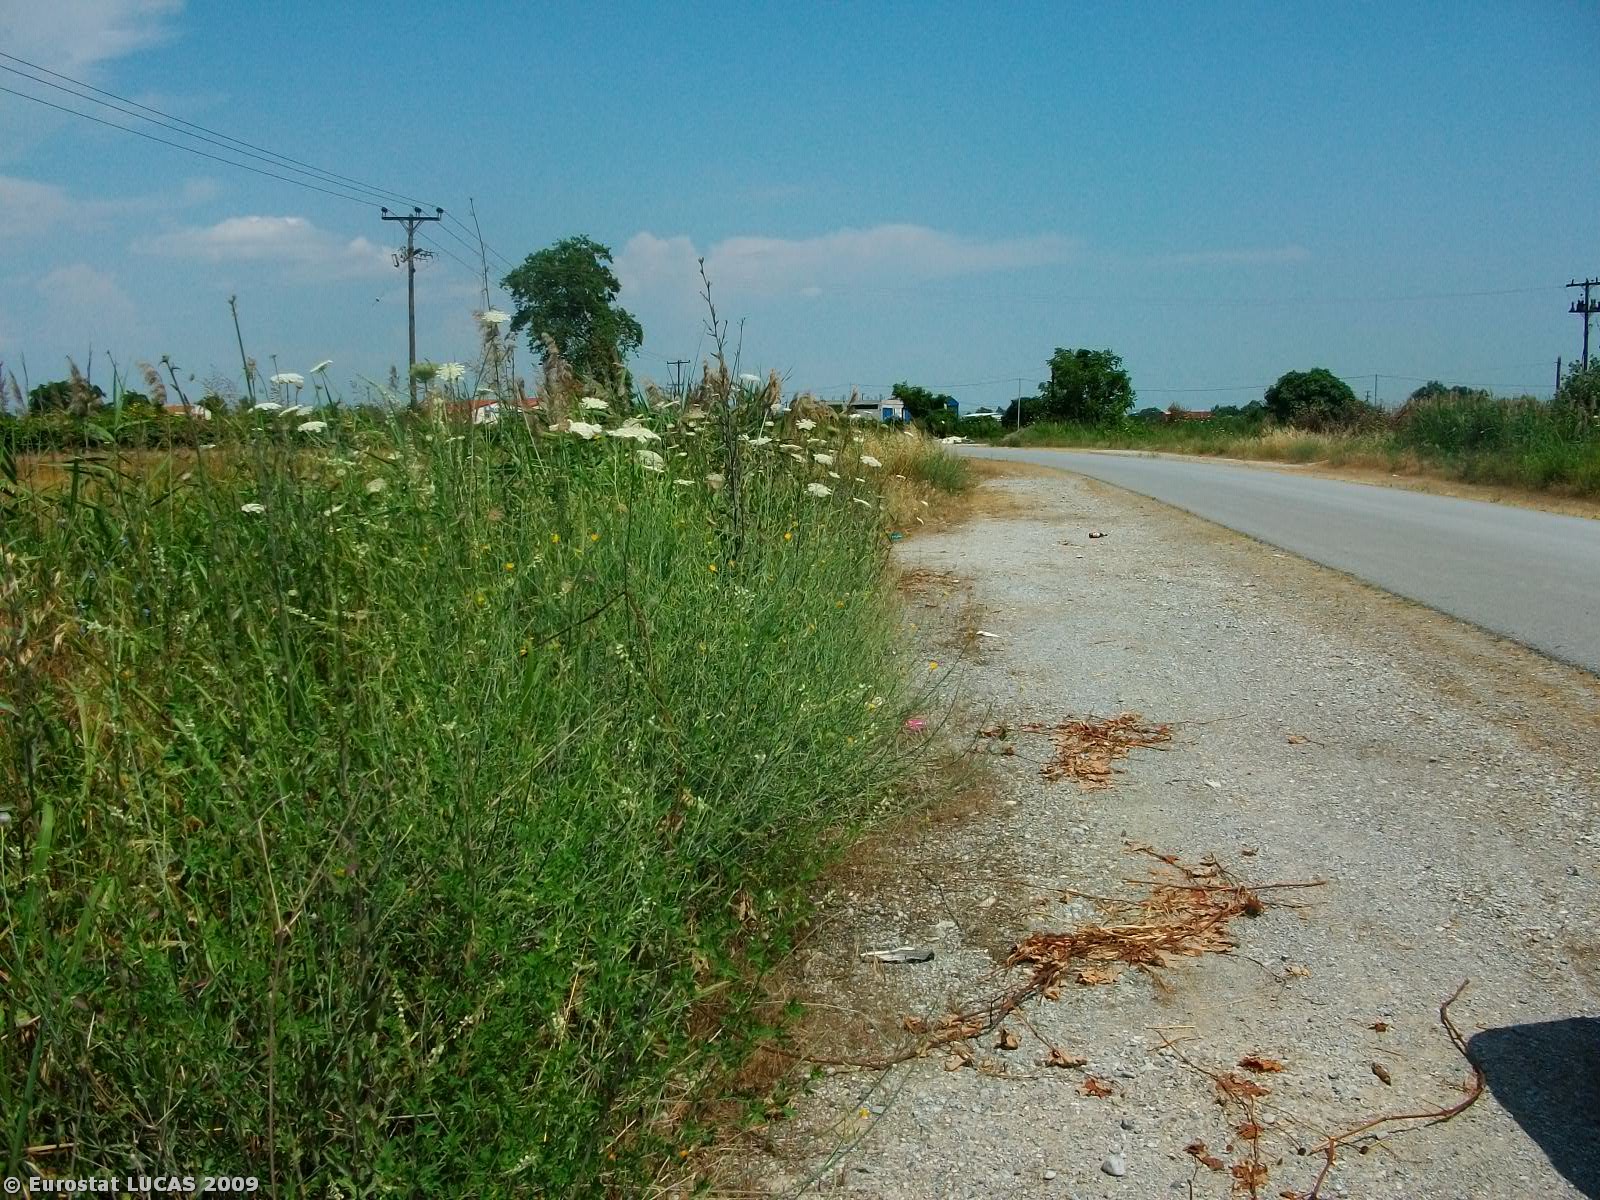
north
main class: Grassland
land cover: Spontaneously vegetated surfaces
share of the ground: > 75 %
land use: Fallow land
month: July
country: GR
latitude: 40.2276
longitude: 22.5378
